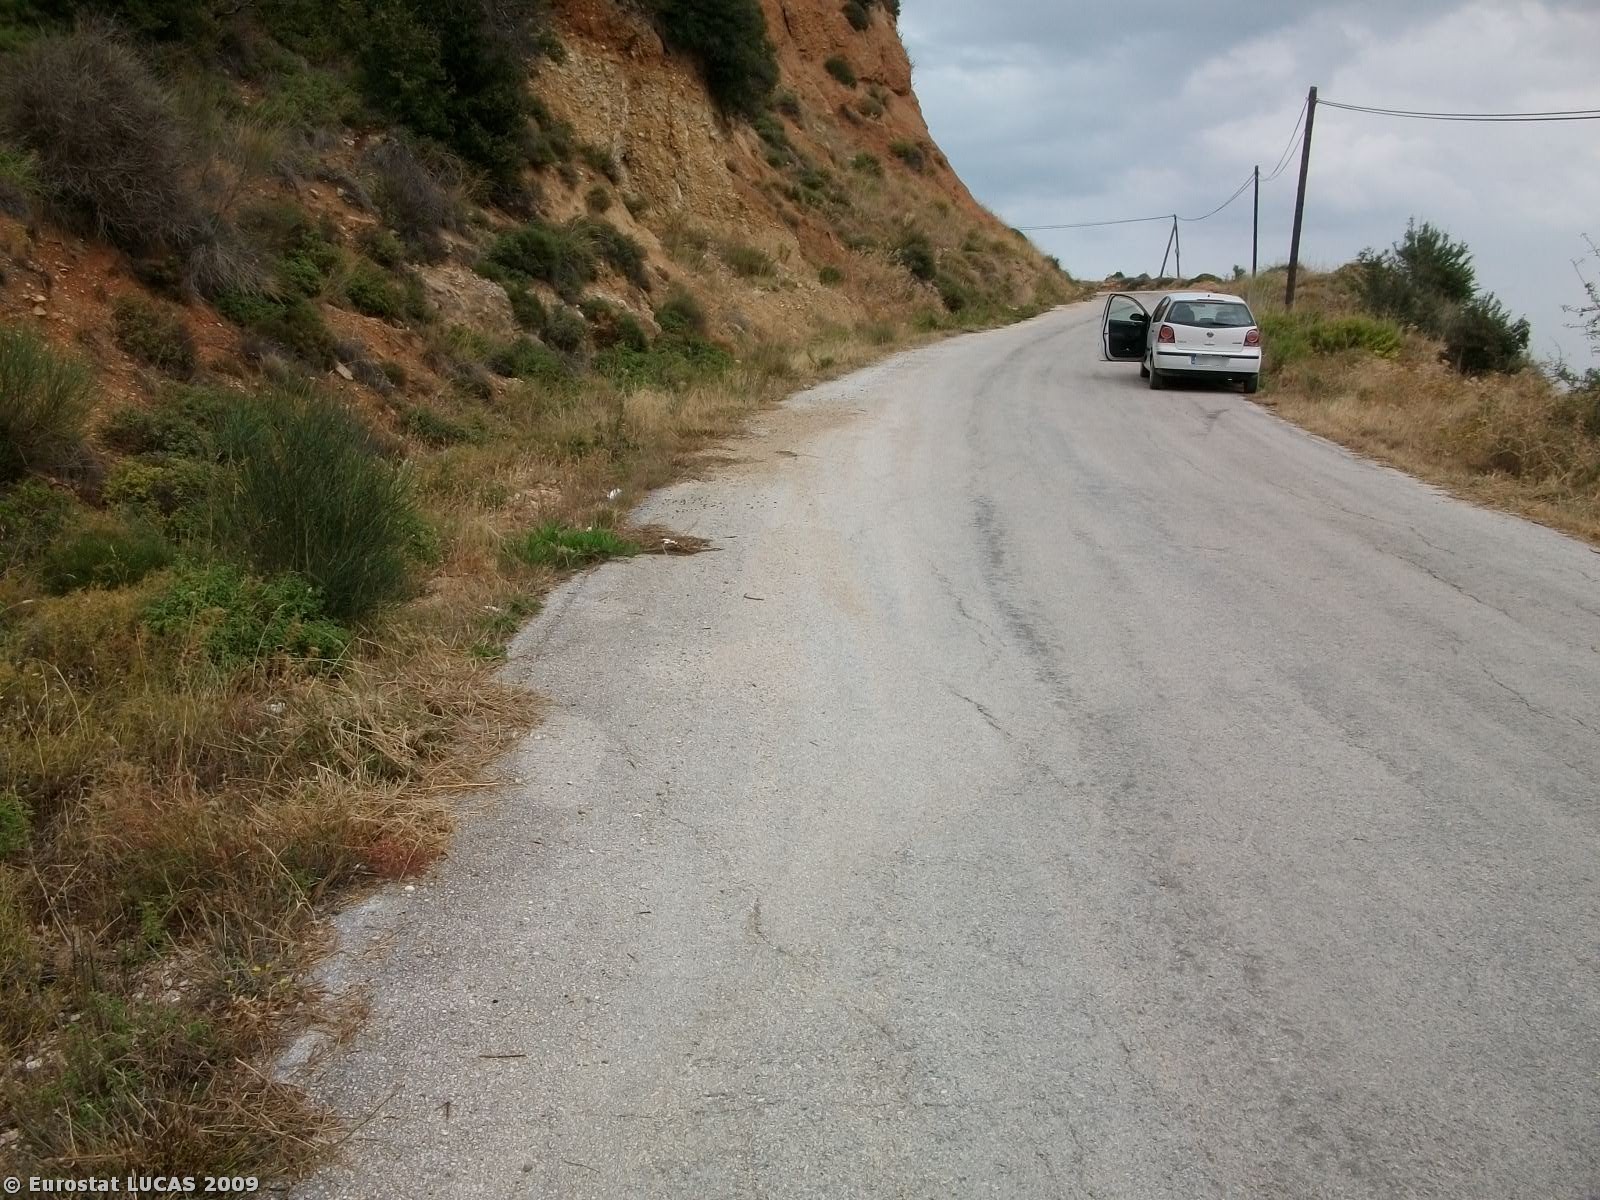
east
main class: Shrubland
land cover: Shrubland without tree cover
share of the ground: > 75 %
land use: Unused
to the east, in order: Shrubland without tree cover; Broadleaved woodland; Shrubland with sparse tree cover; Broadleaved woodland
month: September
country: GR
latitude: 38.0709
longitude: 22.5208
